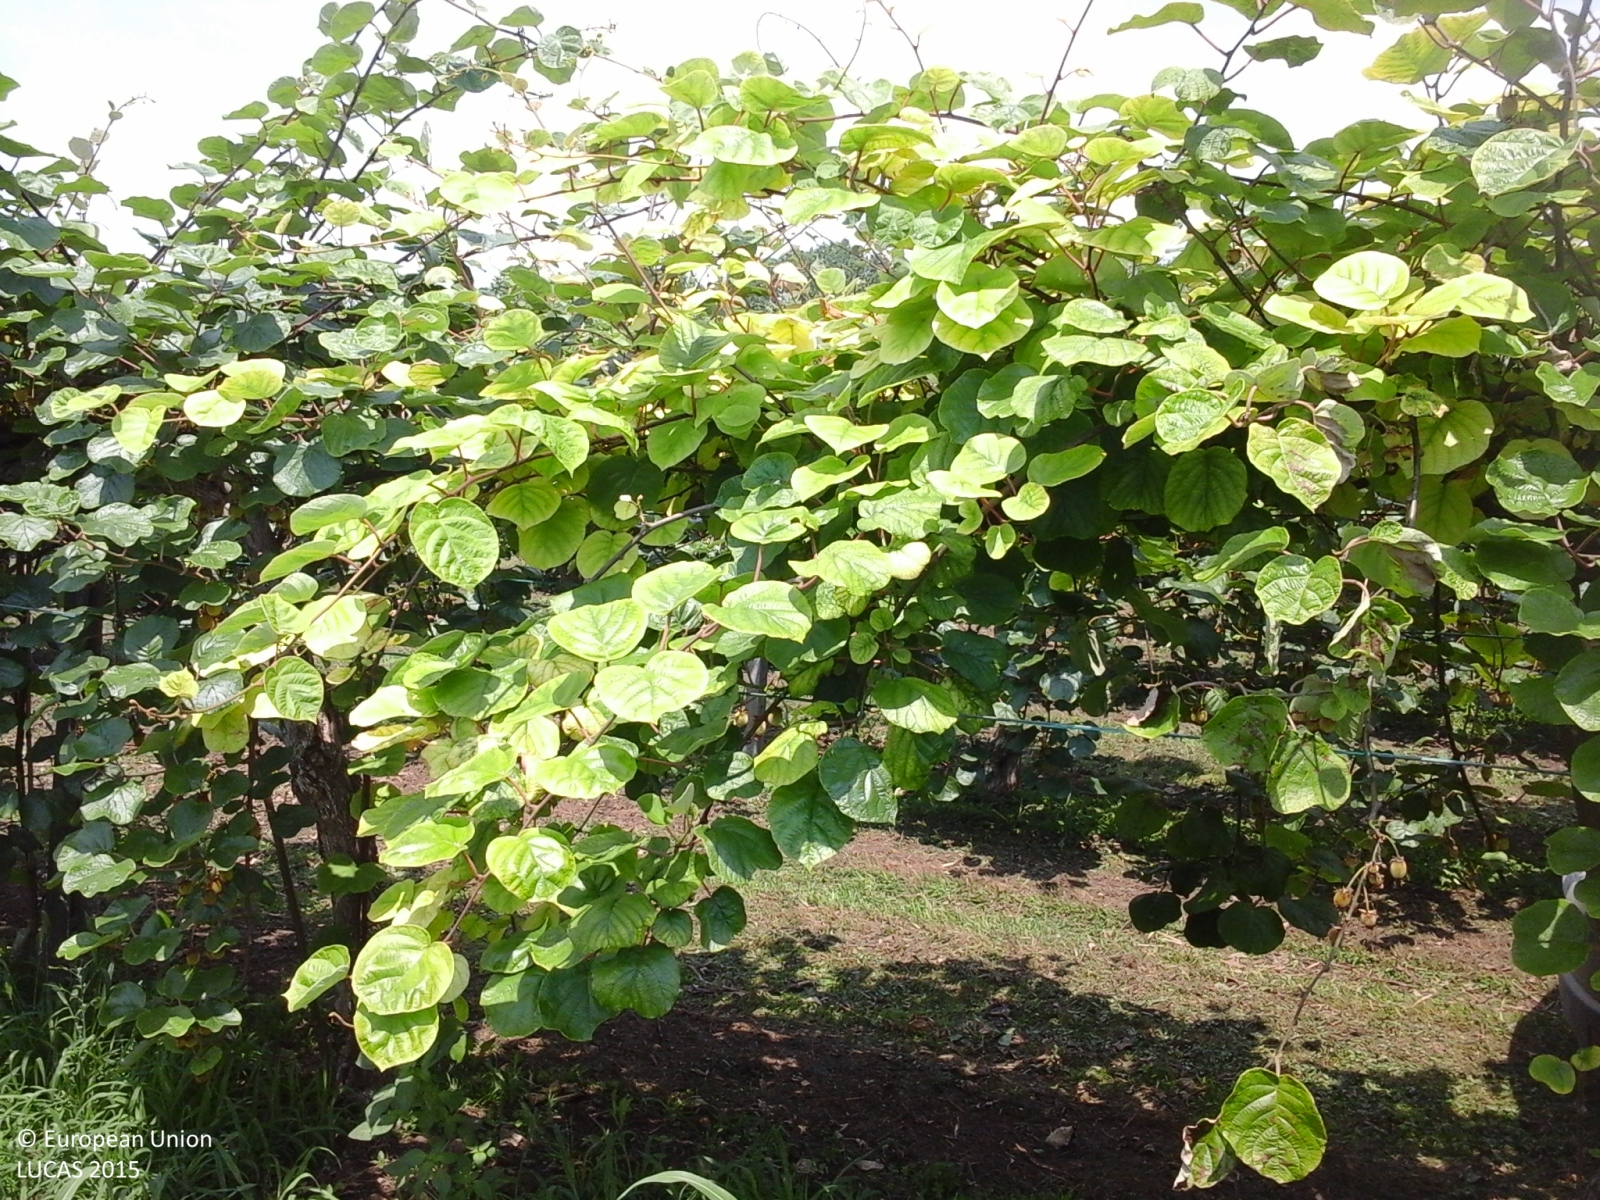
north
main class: Cropland
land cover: Maize
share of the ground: > 75 %
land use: Agriculture (excluding fallow land and kitchen gardens)
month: June
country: IT
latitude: 45.3572
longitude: 10.8028
